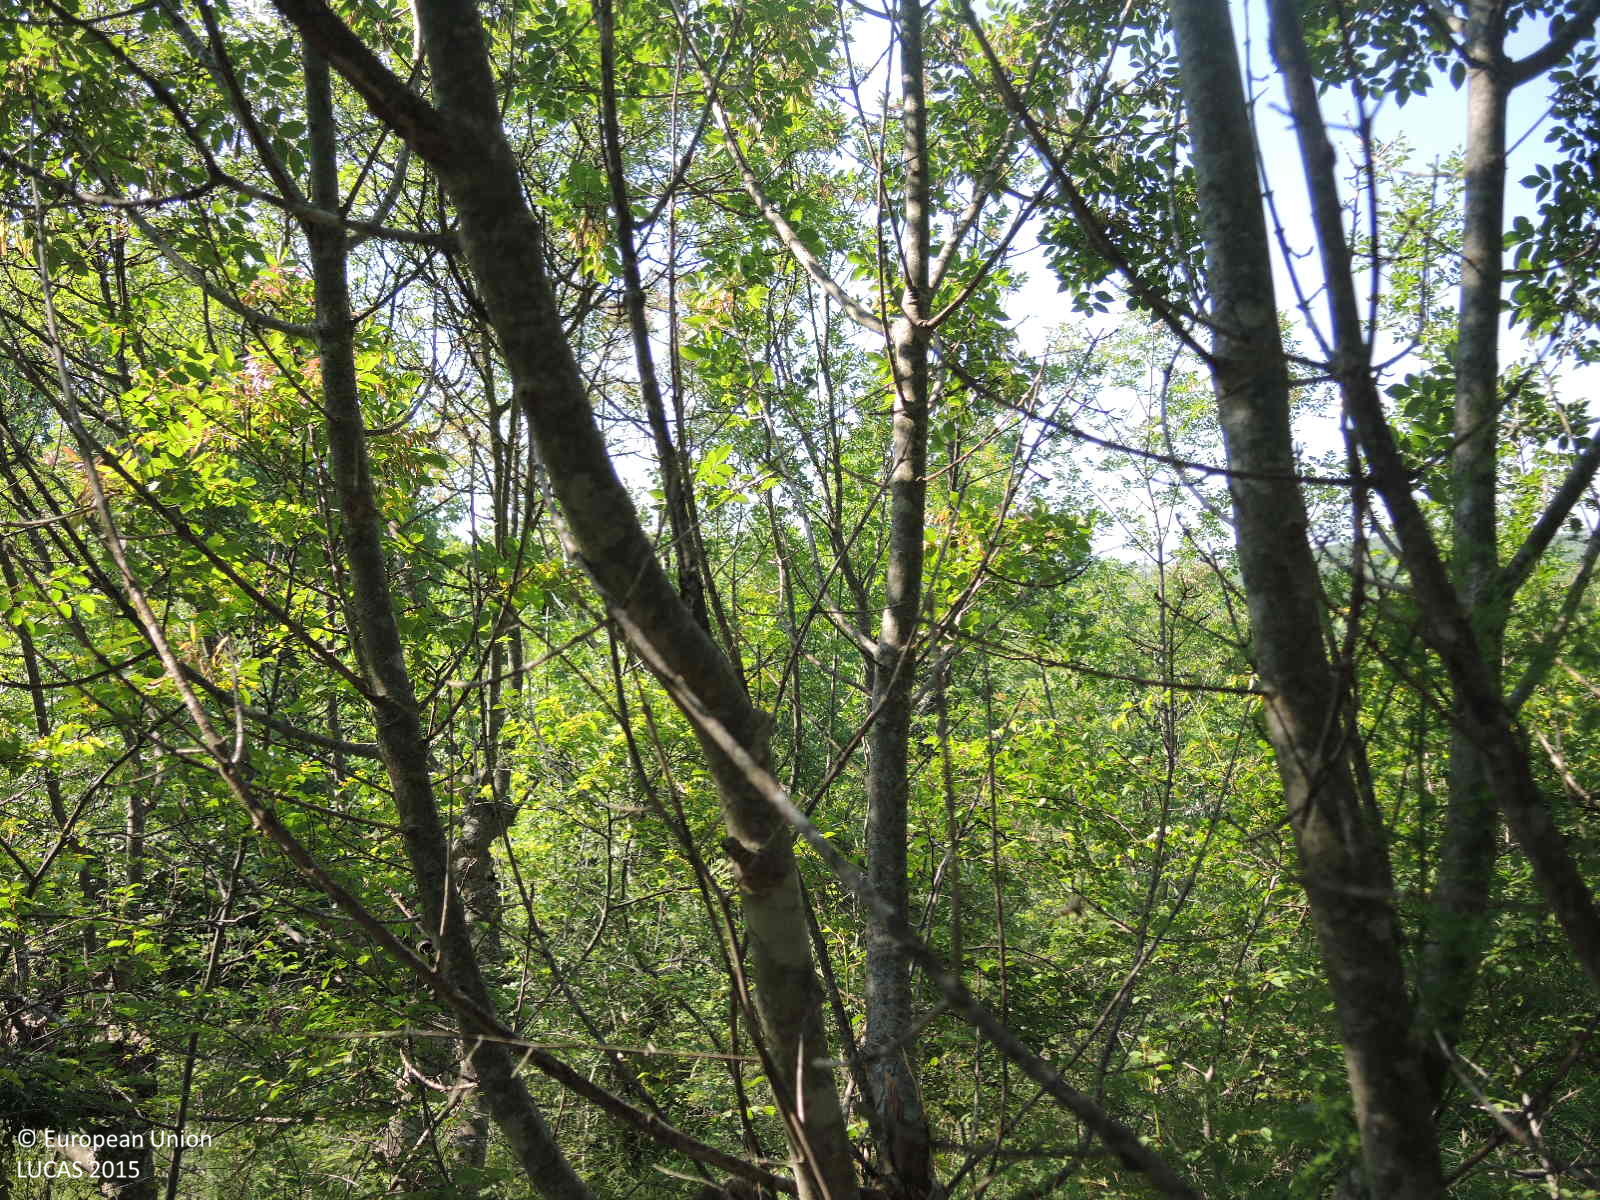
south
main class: Woodland
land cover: Broadleaved woodland
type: mesophytic deciduous forest
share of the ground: 50 - 75 %
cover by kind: broadleaved forest trees 60 %, shrubs 20 %, herbaceous plants 15 %, unconsolidated bare surface 5 %
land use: Semi-natural and natural areas not in use
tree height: > 5 m
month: June
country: HR
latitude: 43.6554
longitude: 16.2528
